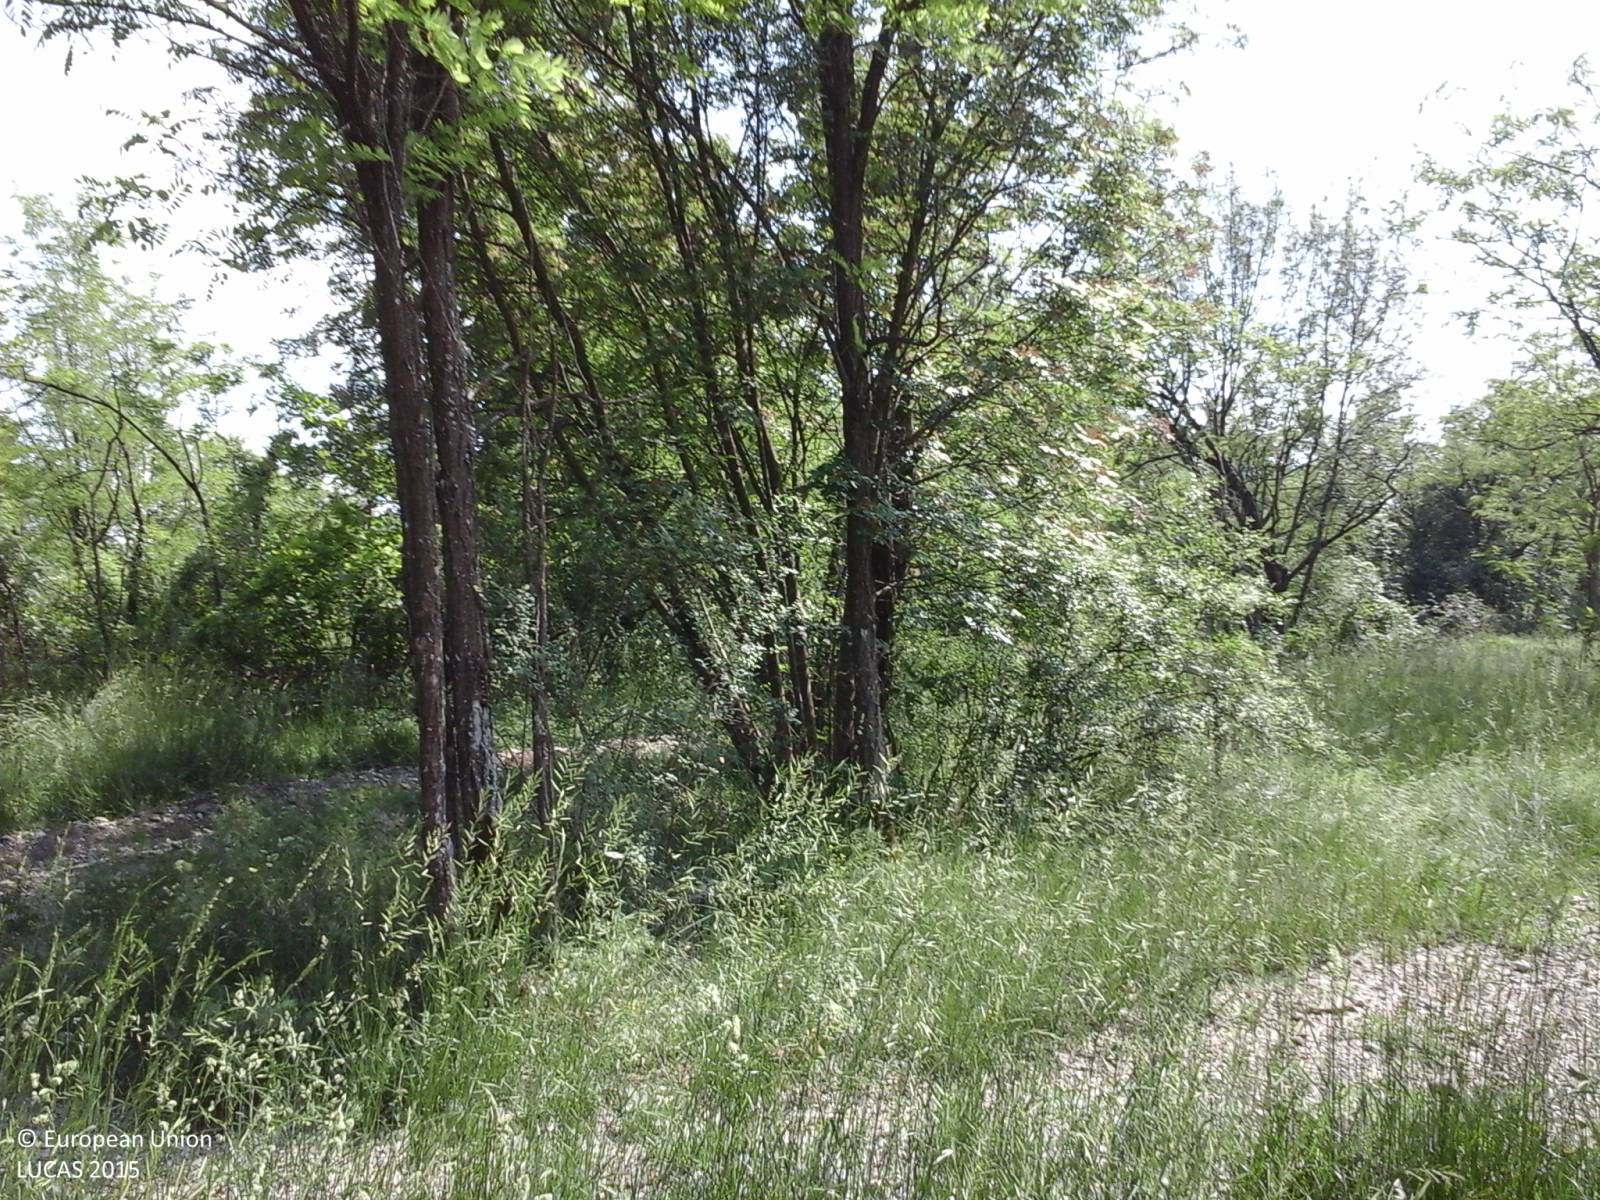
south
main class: Woodland
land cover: Broadleaved woodland
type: mesophytic deciduous forest
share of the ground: > 75 %
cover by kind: broadleaved forest trees 85 %, shrubs 10 %, herbaceous plants 5 %
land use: Forestry
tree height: > 5 m
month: May
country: IT
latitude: 46.0114
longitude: 13.3155
